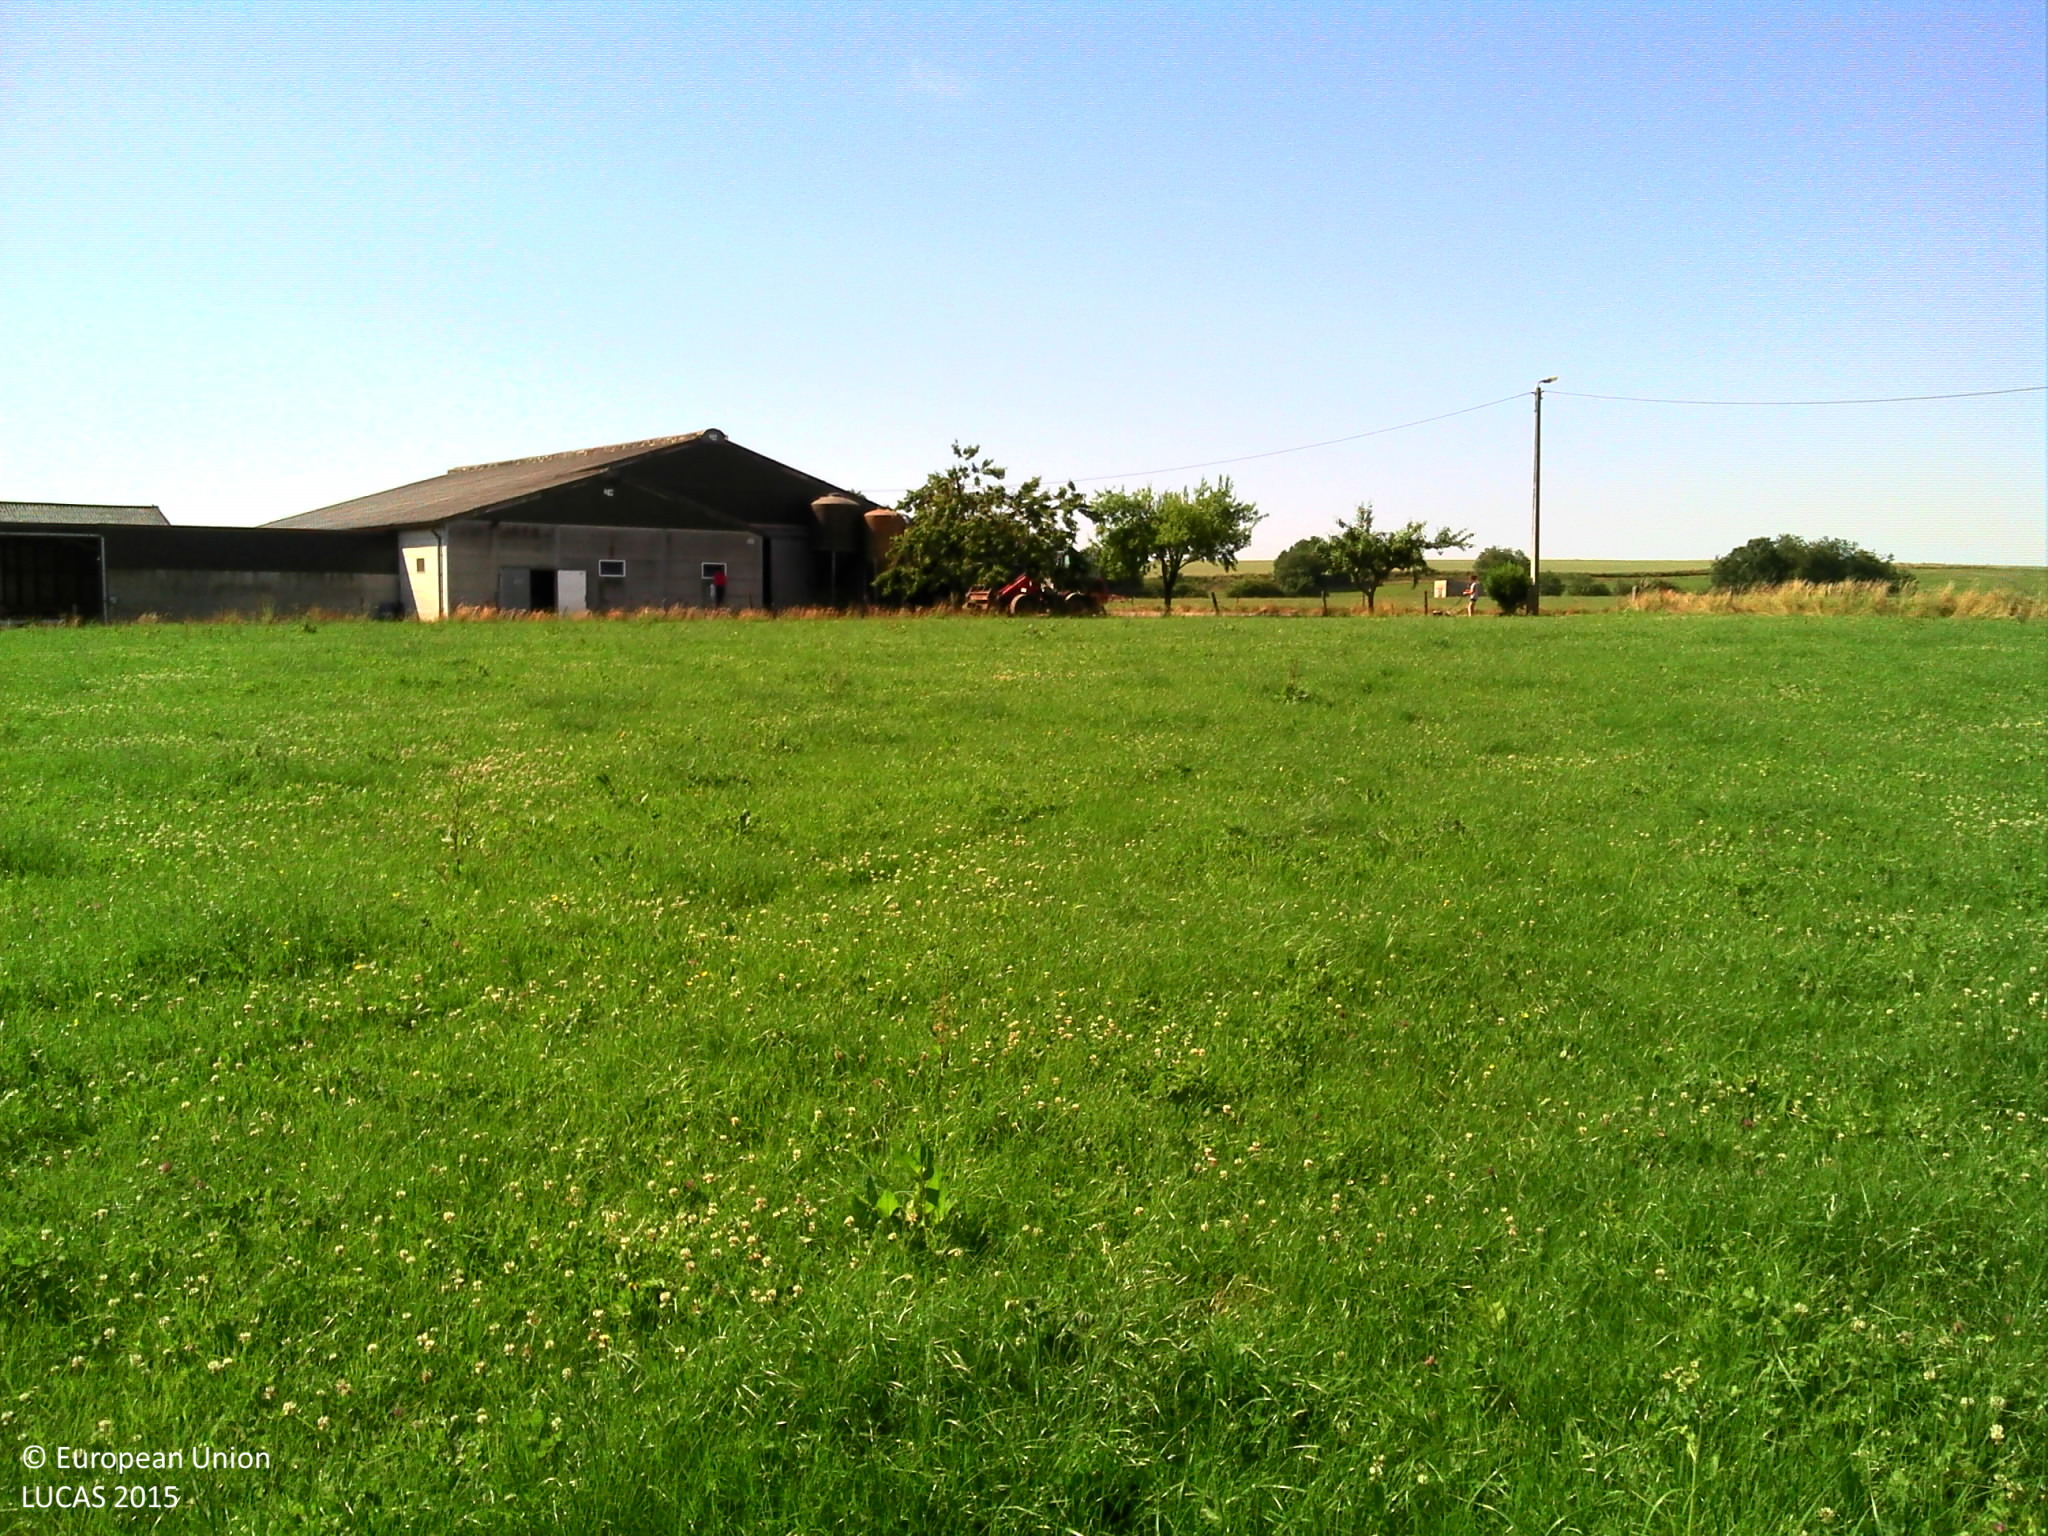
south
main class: Grassland
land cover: Grassland without tree/shrub cover
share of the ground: > 75 %
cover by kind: herbaceous plants 100 %
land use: Agriculture (excluding fallow land and kitchen gardens)
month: July
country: BE
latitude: 50.2942
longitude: 4.6763
